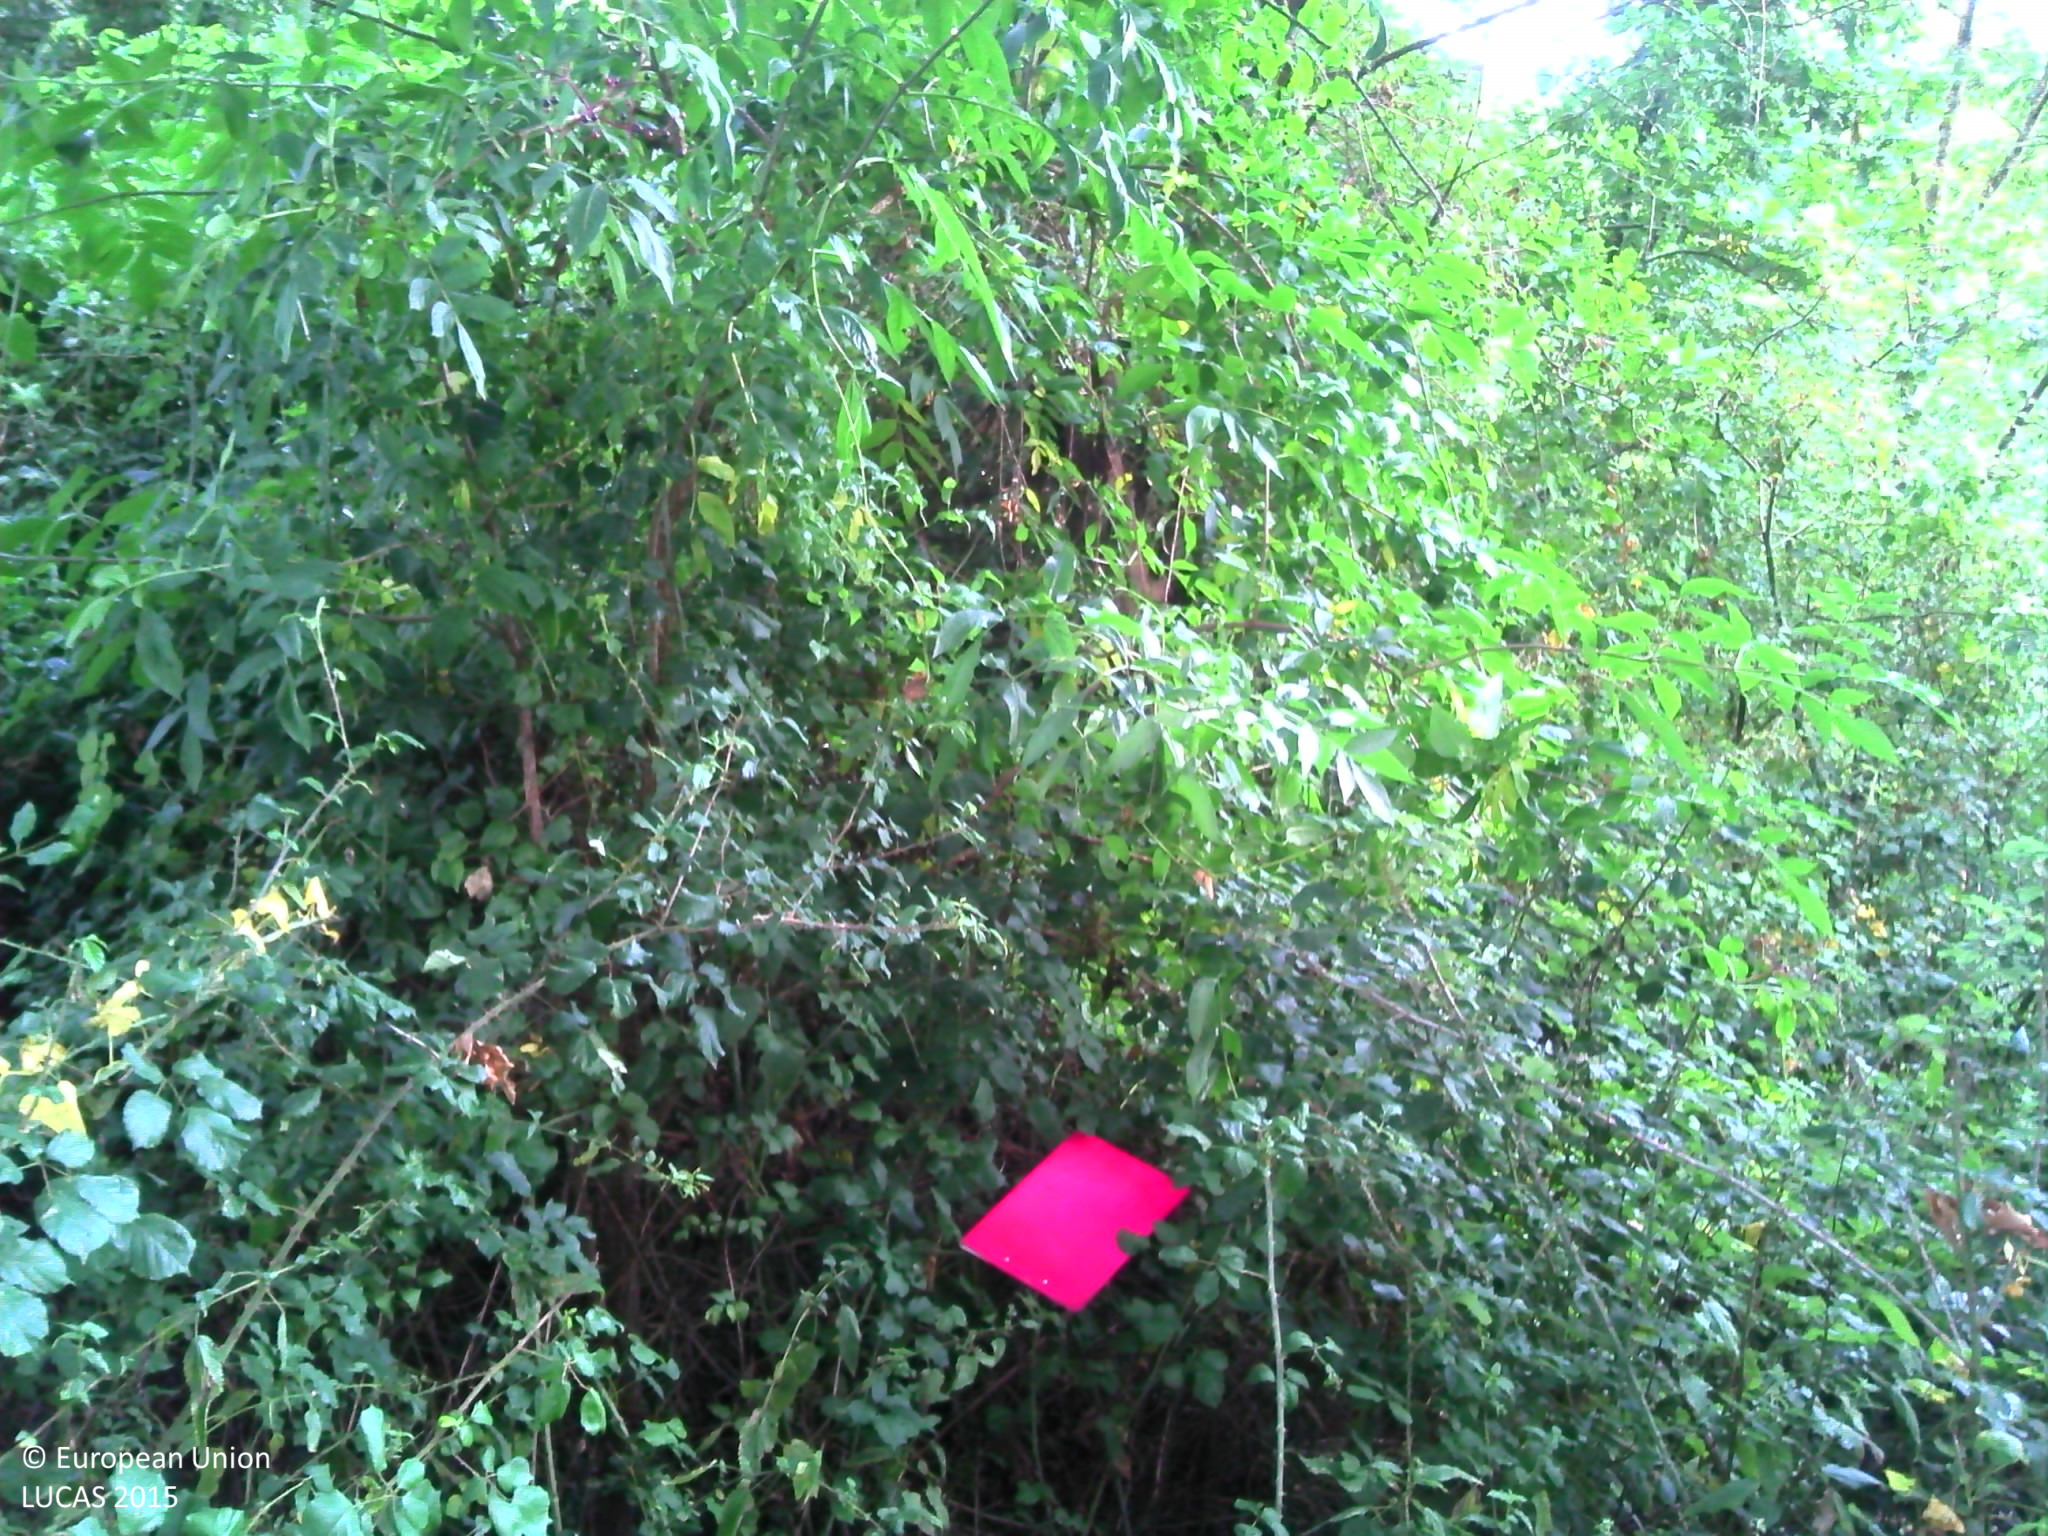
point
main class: Woodland
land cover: Broadleaved woodland
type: mesophytic deciduous forest
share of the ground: > 75 %
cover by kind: broadleaved forest trees 65 %, shrubs 30 %, herbaceous plants 5 %
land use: Semi-natural and natural areas not in use
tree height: > 5 m
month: August
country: FR
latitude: 43.3728
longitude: -1.0839
